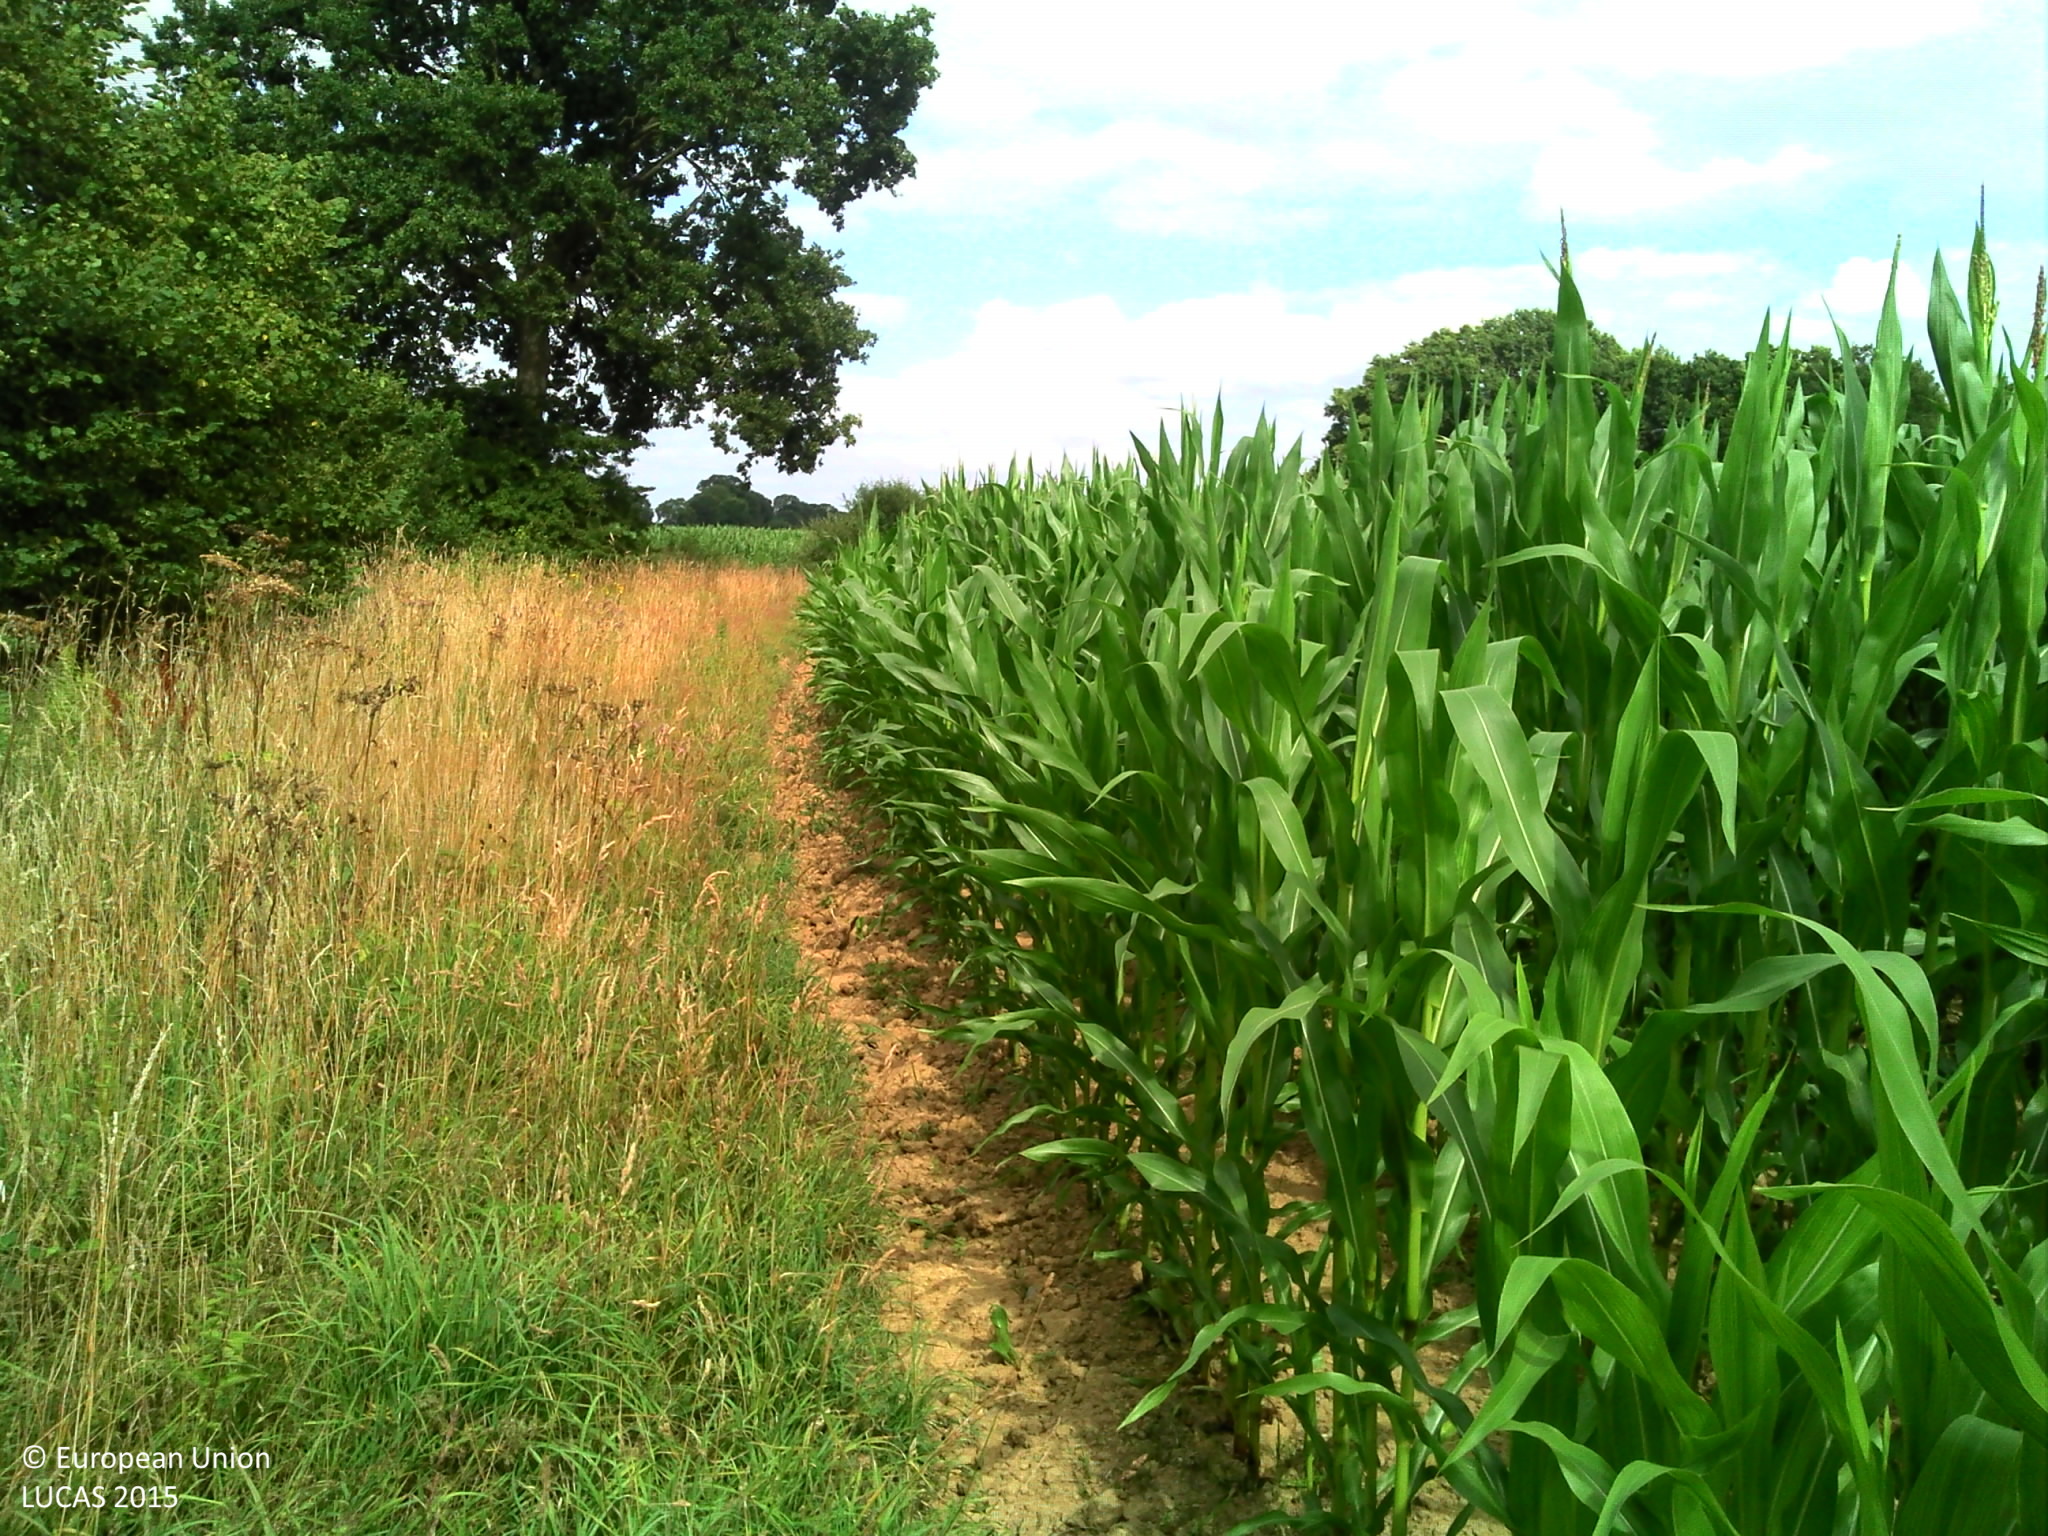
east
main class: Cropland
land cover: Maize
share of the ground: > 75 %
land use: Agriculture (excluding fallow land and kitchen gardens)
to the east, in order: Maize; Grass margins; Ditches and canals; Tracks; Grass margins; Lines of trees; Rivers and streams; Broadleaved woodland; Spontaneously vegetated surfaces; Broadleaved woodland; Lines of trees
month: July
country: FR
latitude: 48.0828
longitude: -1.4145
